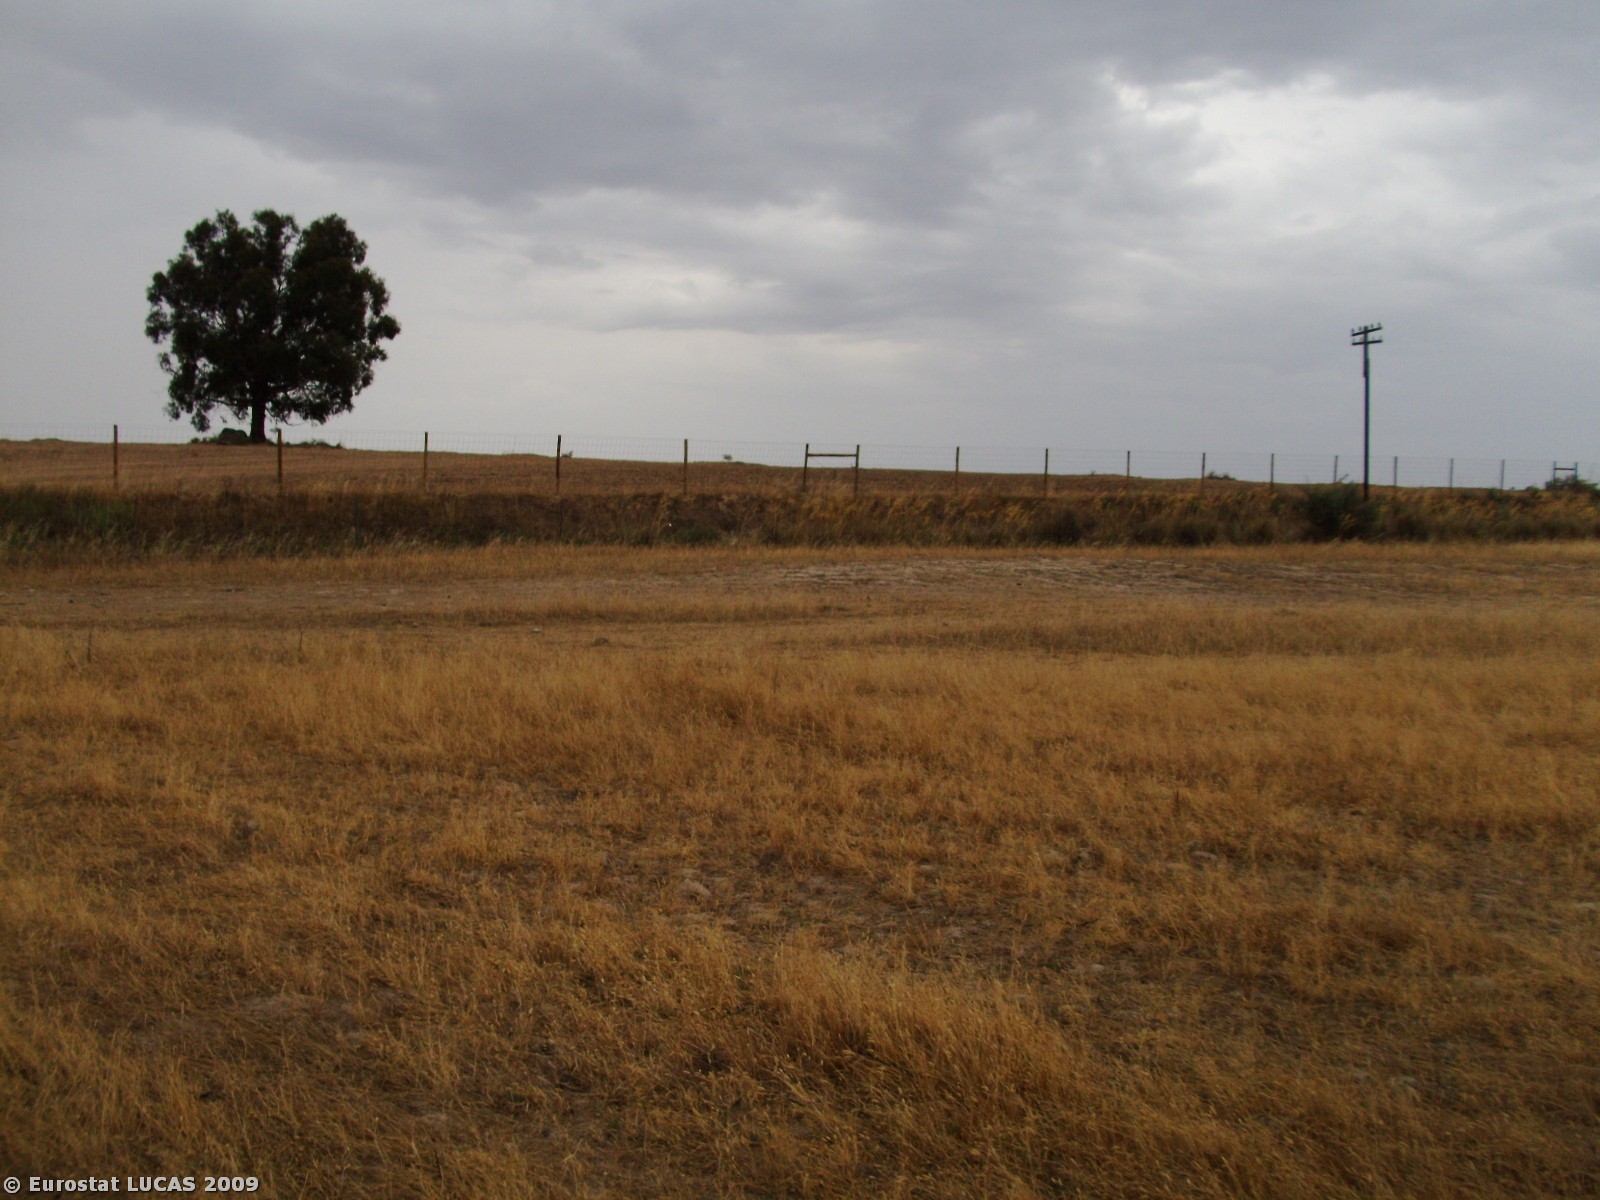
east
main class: Grassland
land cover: Spontaneously vegetated surfaces
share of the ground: > 75 %
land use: Fallow land
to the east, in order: Spontaneously vegetated surfaces; Fences; Railways; Fences; Spontaneously vegetated surfaces; Tracks; Spontaneously vegetated surfaces
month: June
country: PT
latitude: 39.9478
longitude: -7.4340
